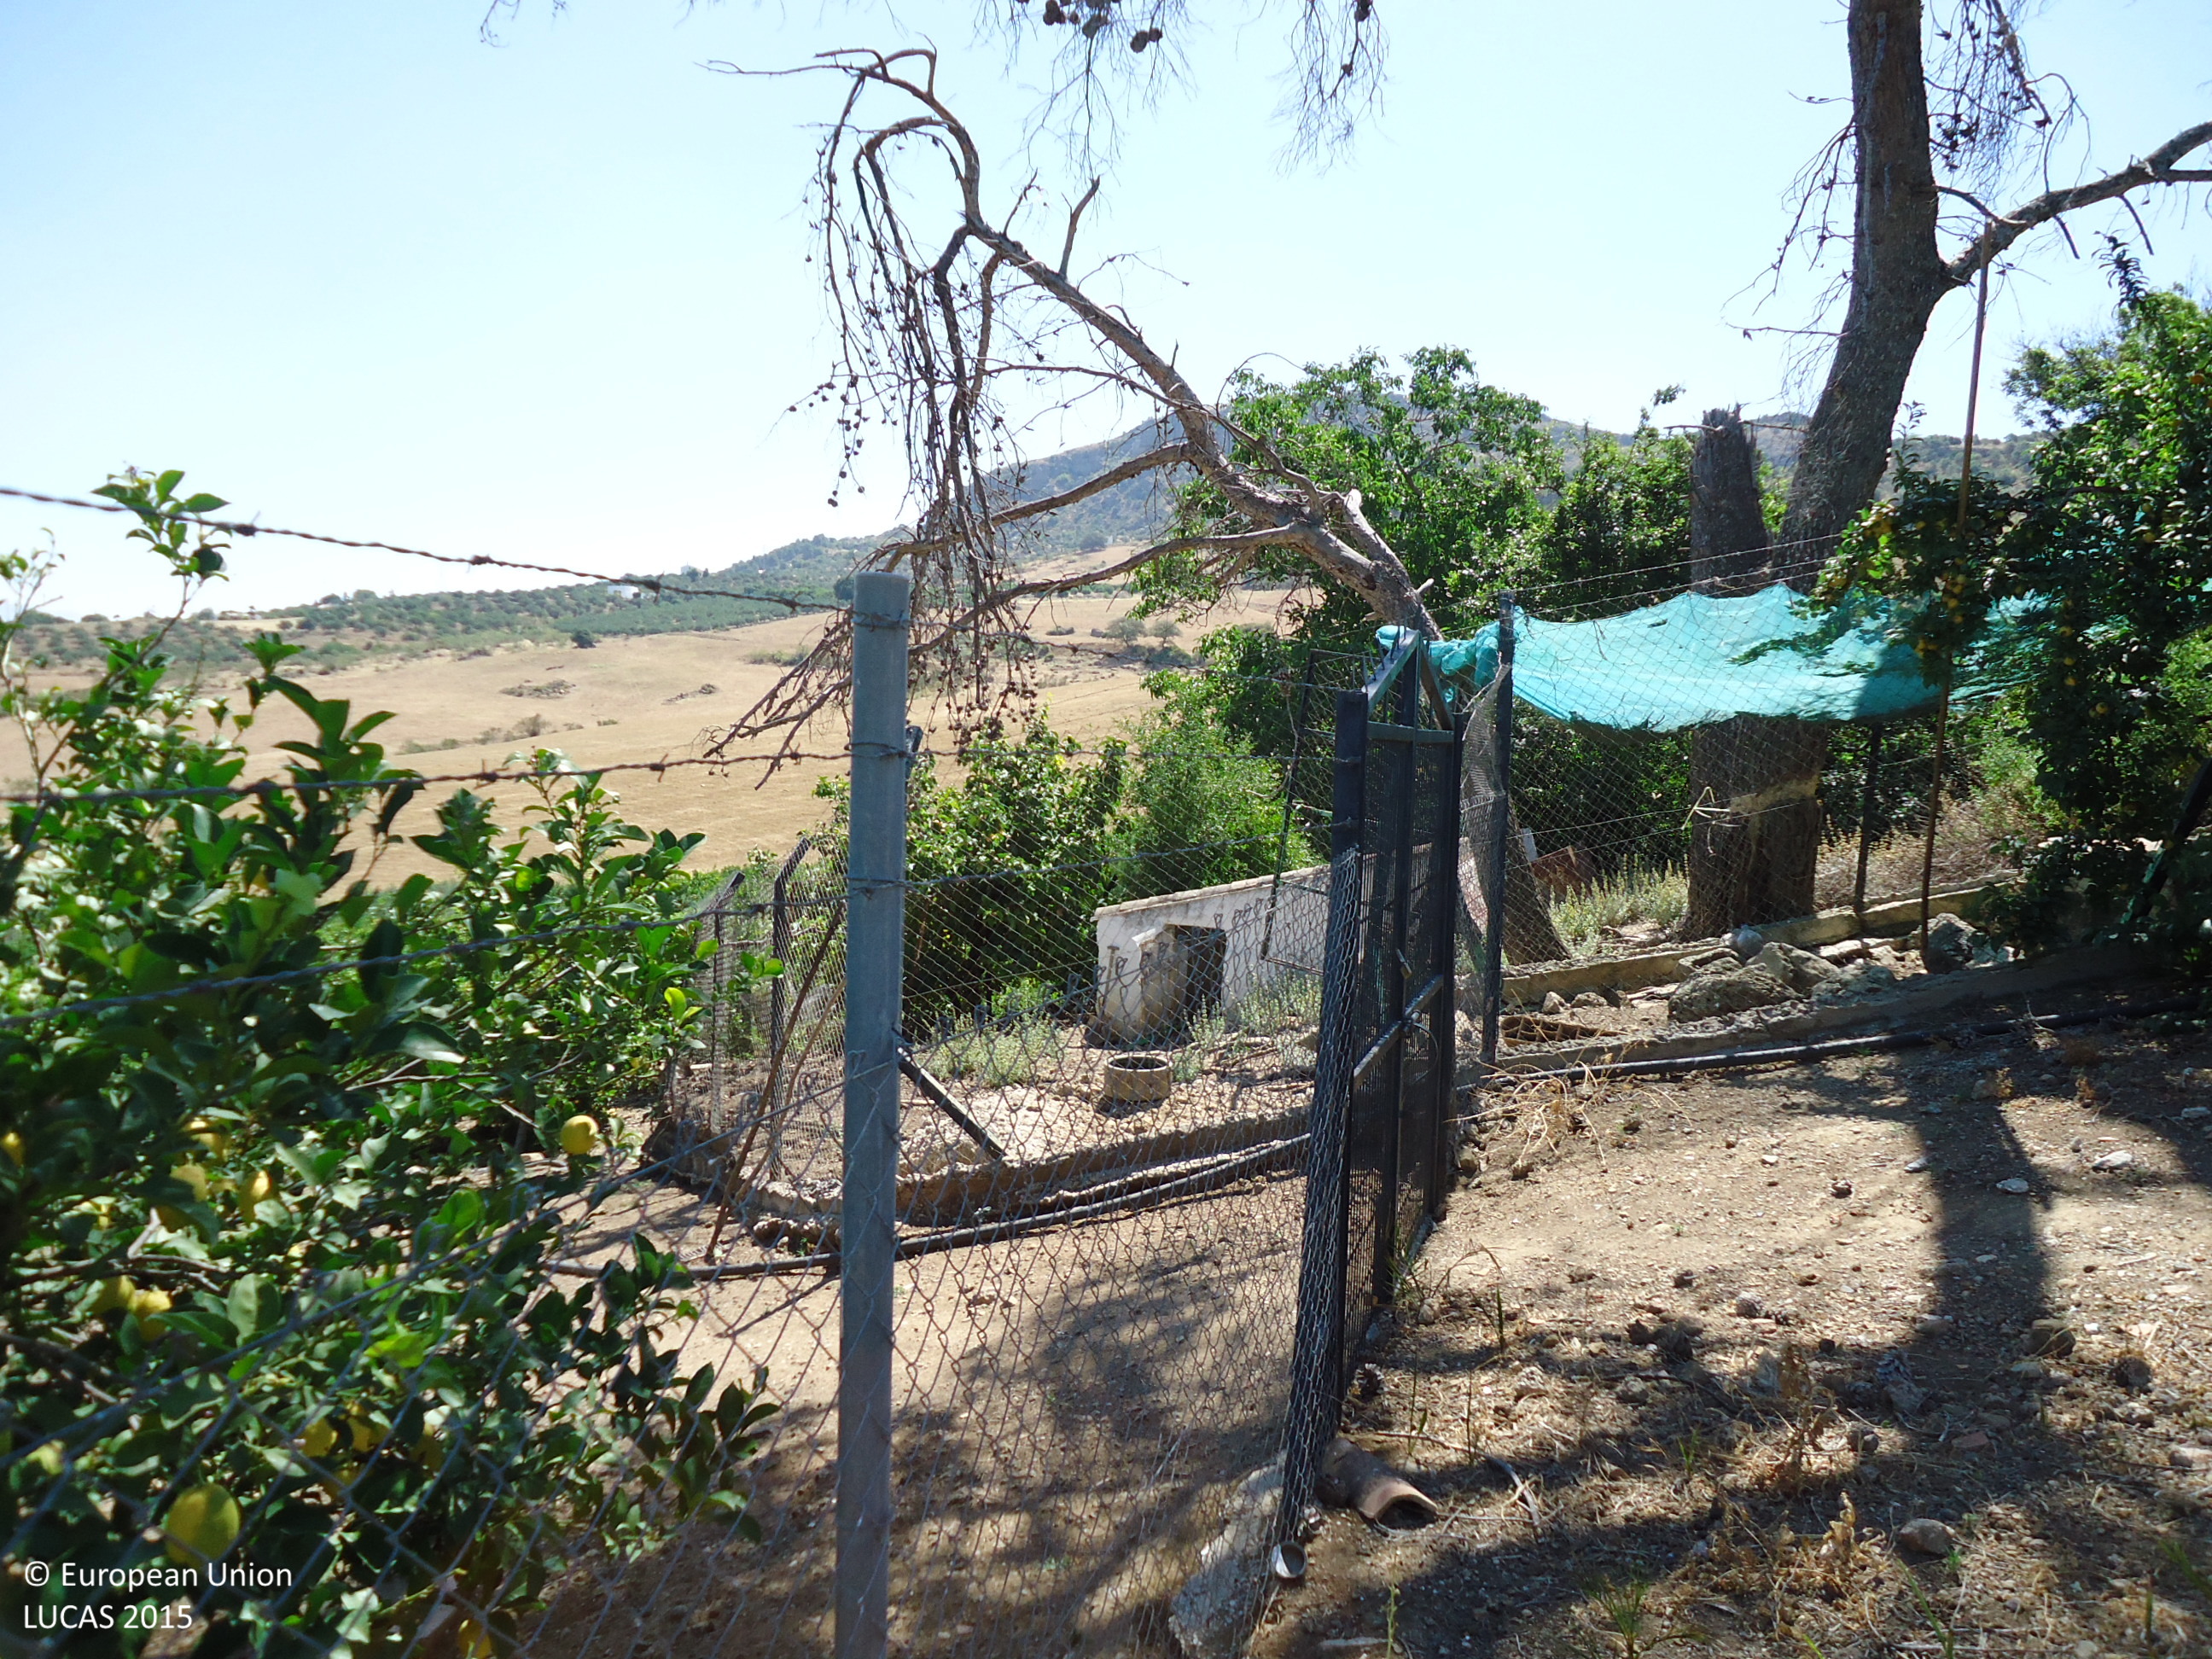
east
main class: Cropland
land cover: Other citrus fruit
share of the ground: > 75 %
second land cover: Other bare soil
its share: > 75 %
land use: Agriculture (excluding fallow land and kitchen gardens)
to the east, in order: Other citrus fruit; Other bare soil; Fences; Spontaneously vegetated surfaces
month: June
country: ES
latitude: 36.8313
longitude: -4.7397
